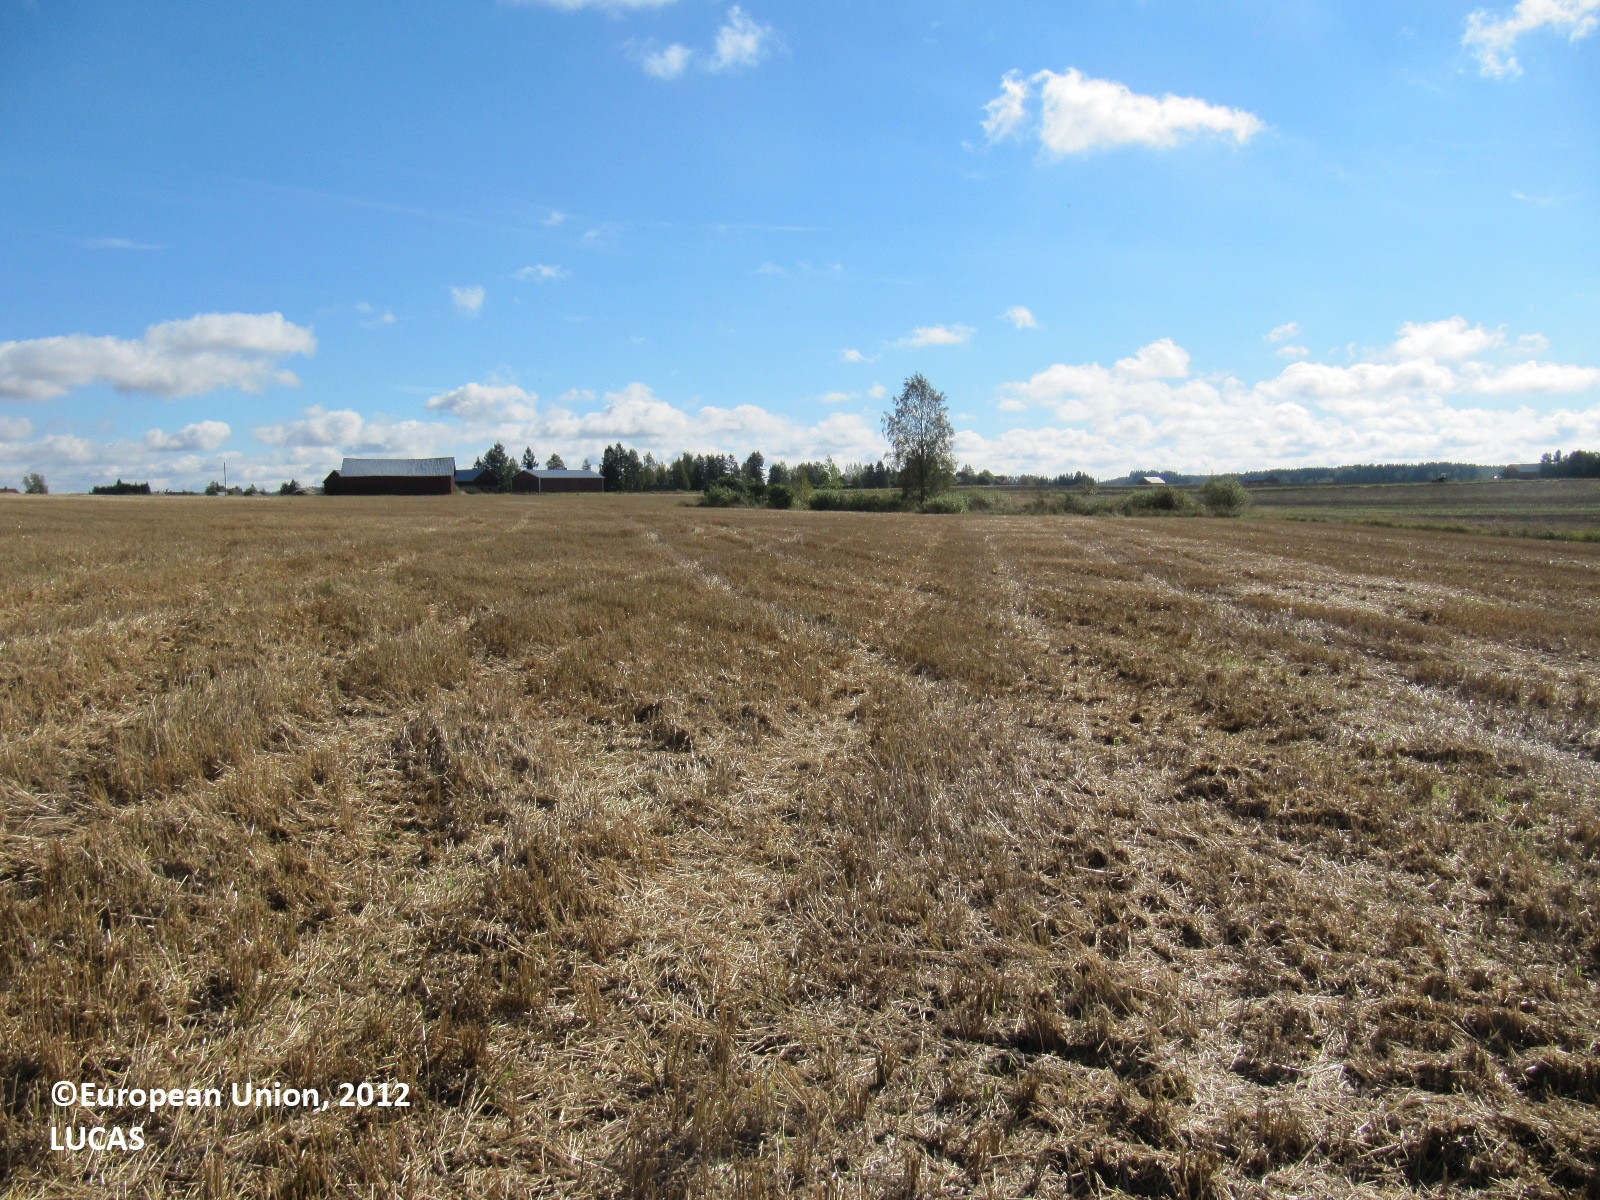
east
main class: Cropland
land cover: Barley
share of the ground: 50 - 75 %
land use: Agriculture (excluding fallow land and kitchen gardens)
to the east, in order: Barley
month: September
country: FI
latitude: 60.7925
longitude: 23.2898
